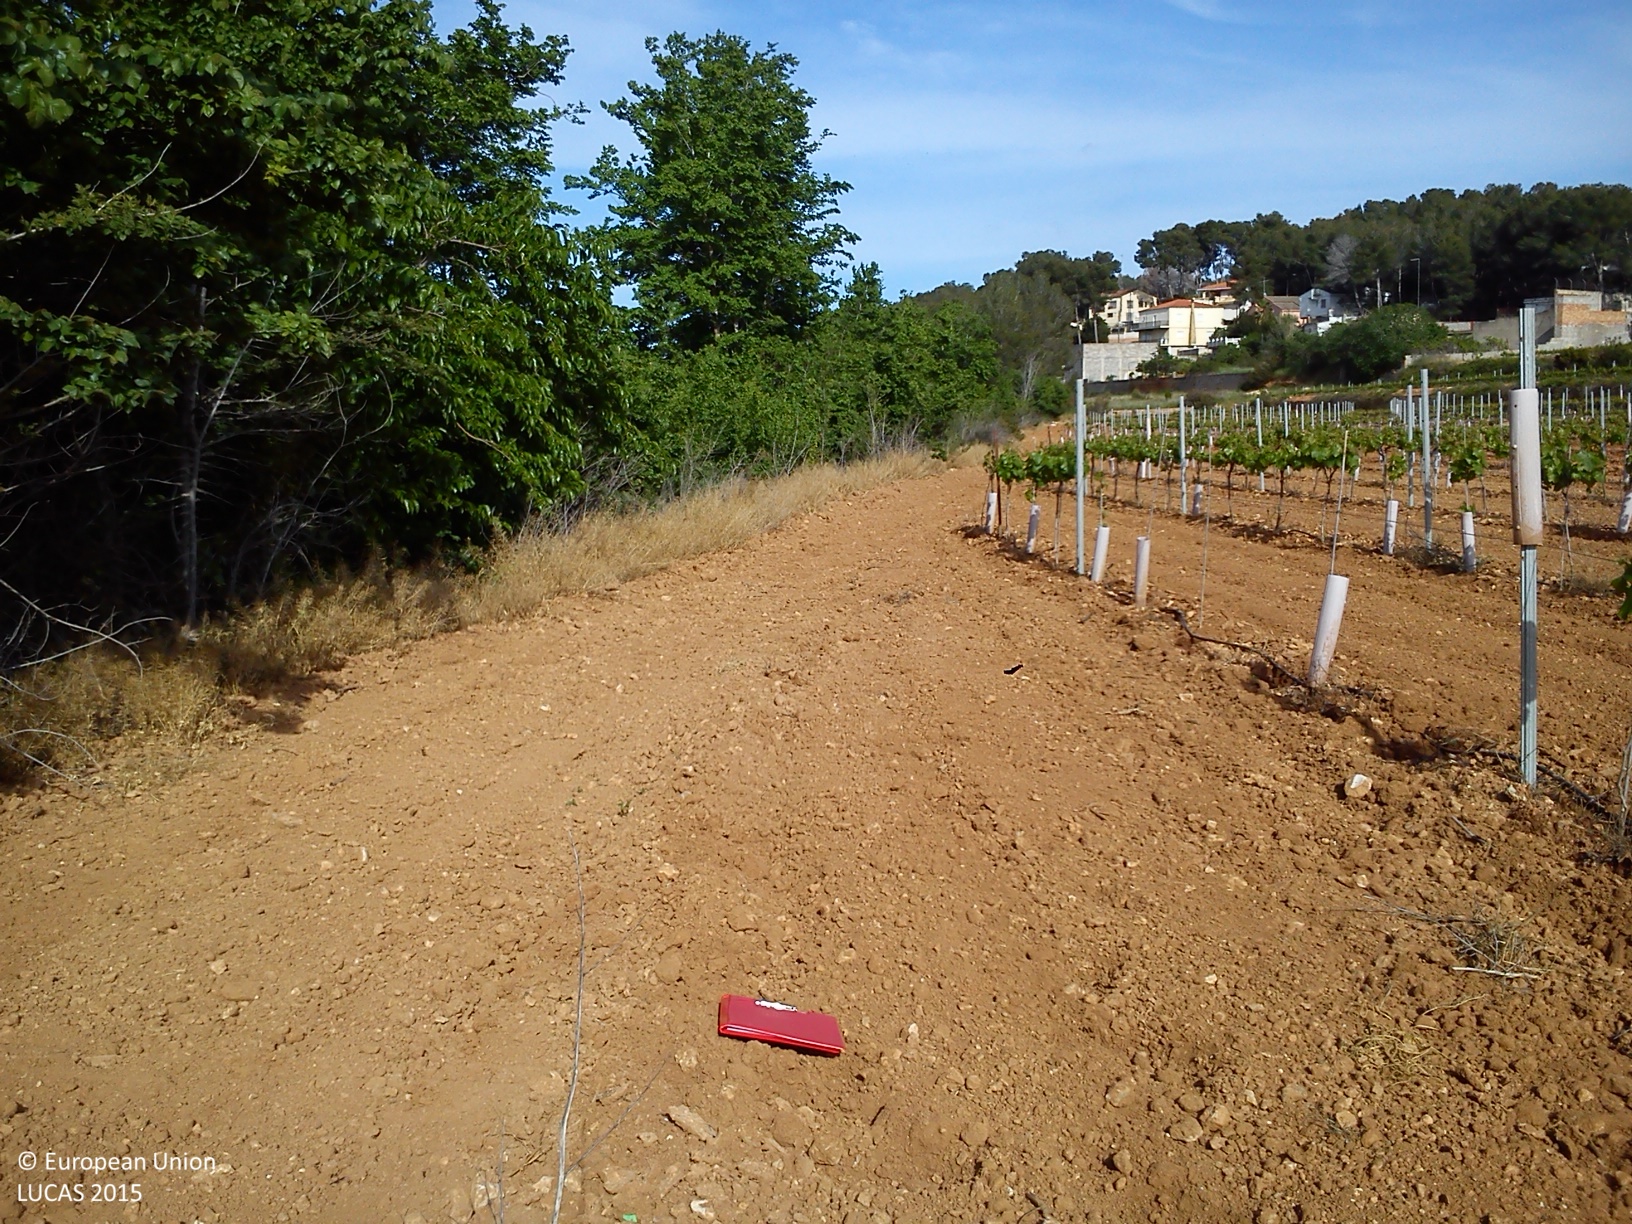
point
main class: Cropland
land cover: Vineyards
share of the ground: 10 - 25 %
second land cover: Other bare soil
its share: > 75 %
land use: Agriculture (excluding fallow land and kitchen gardens)
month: April
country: ES
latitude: 39.4330
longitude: -0.6283
